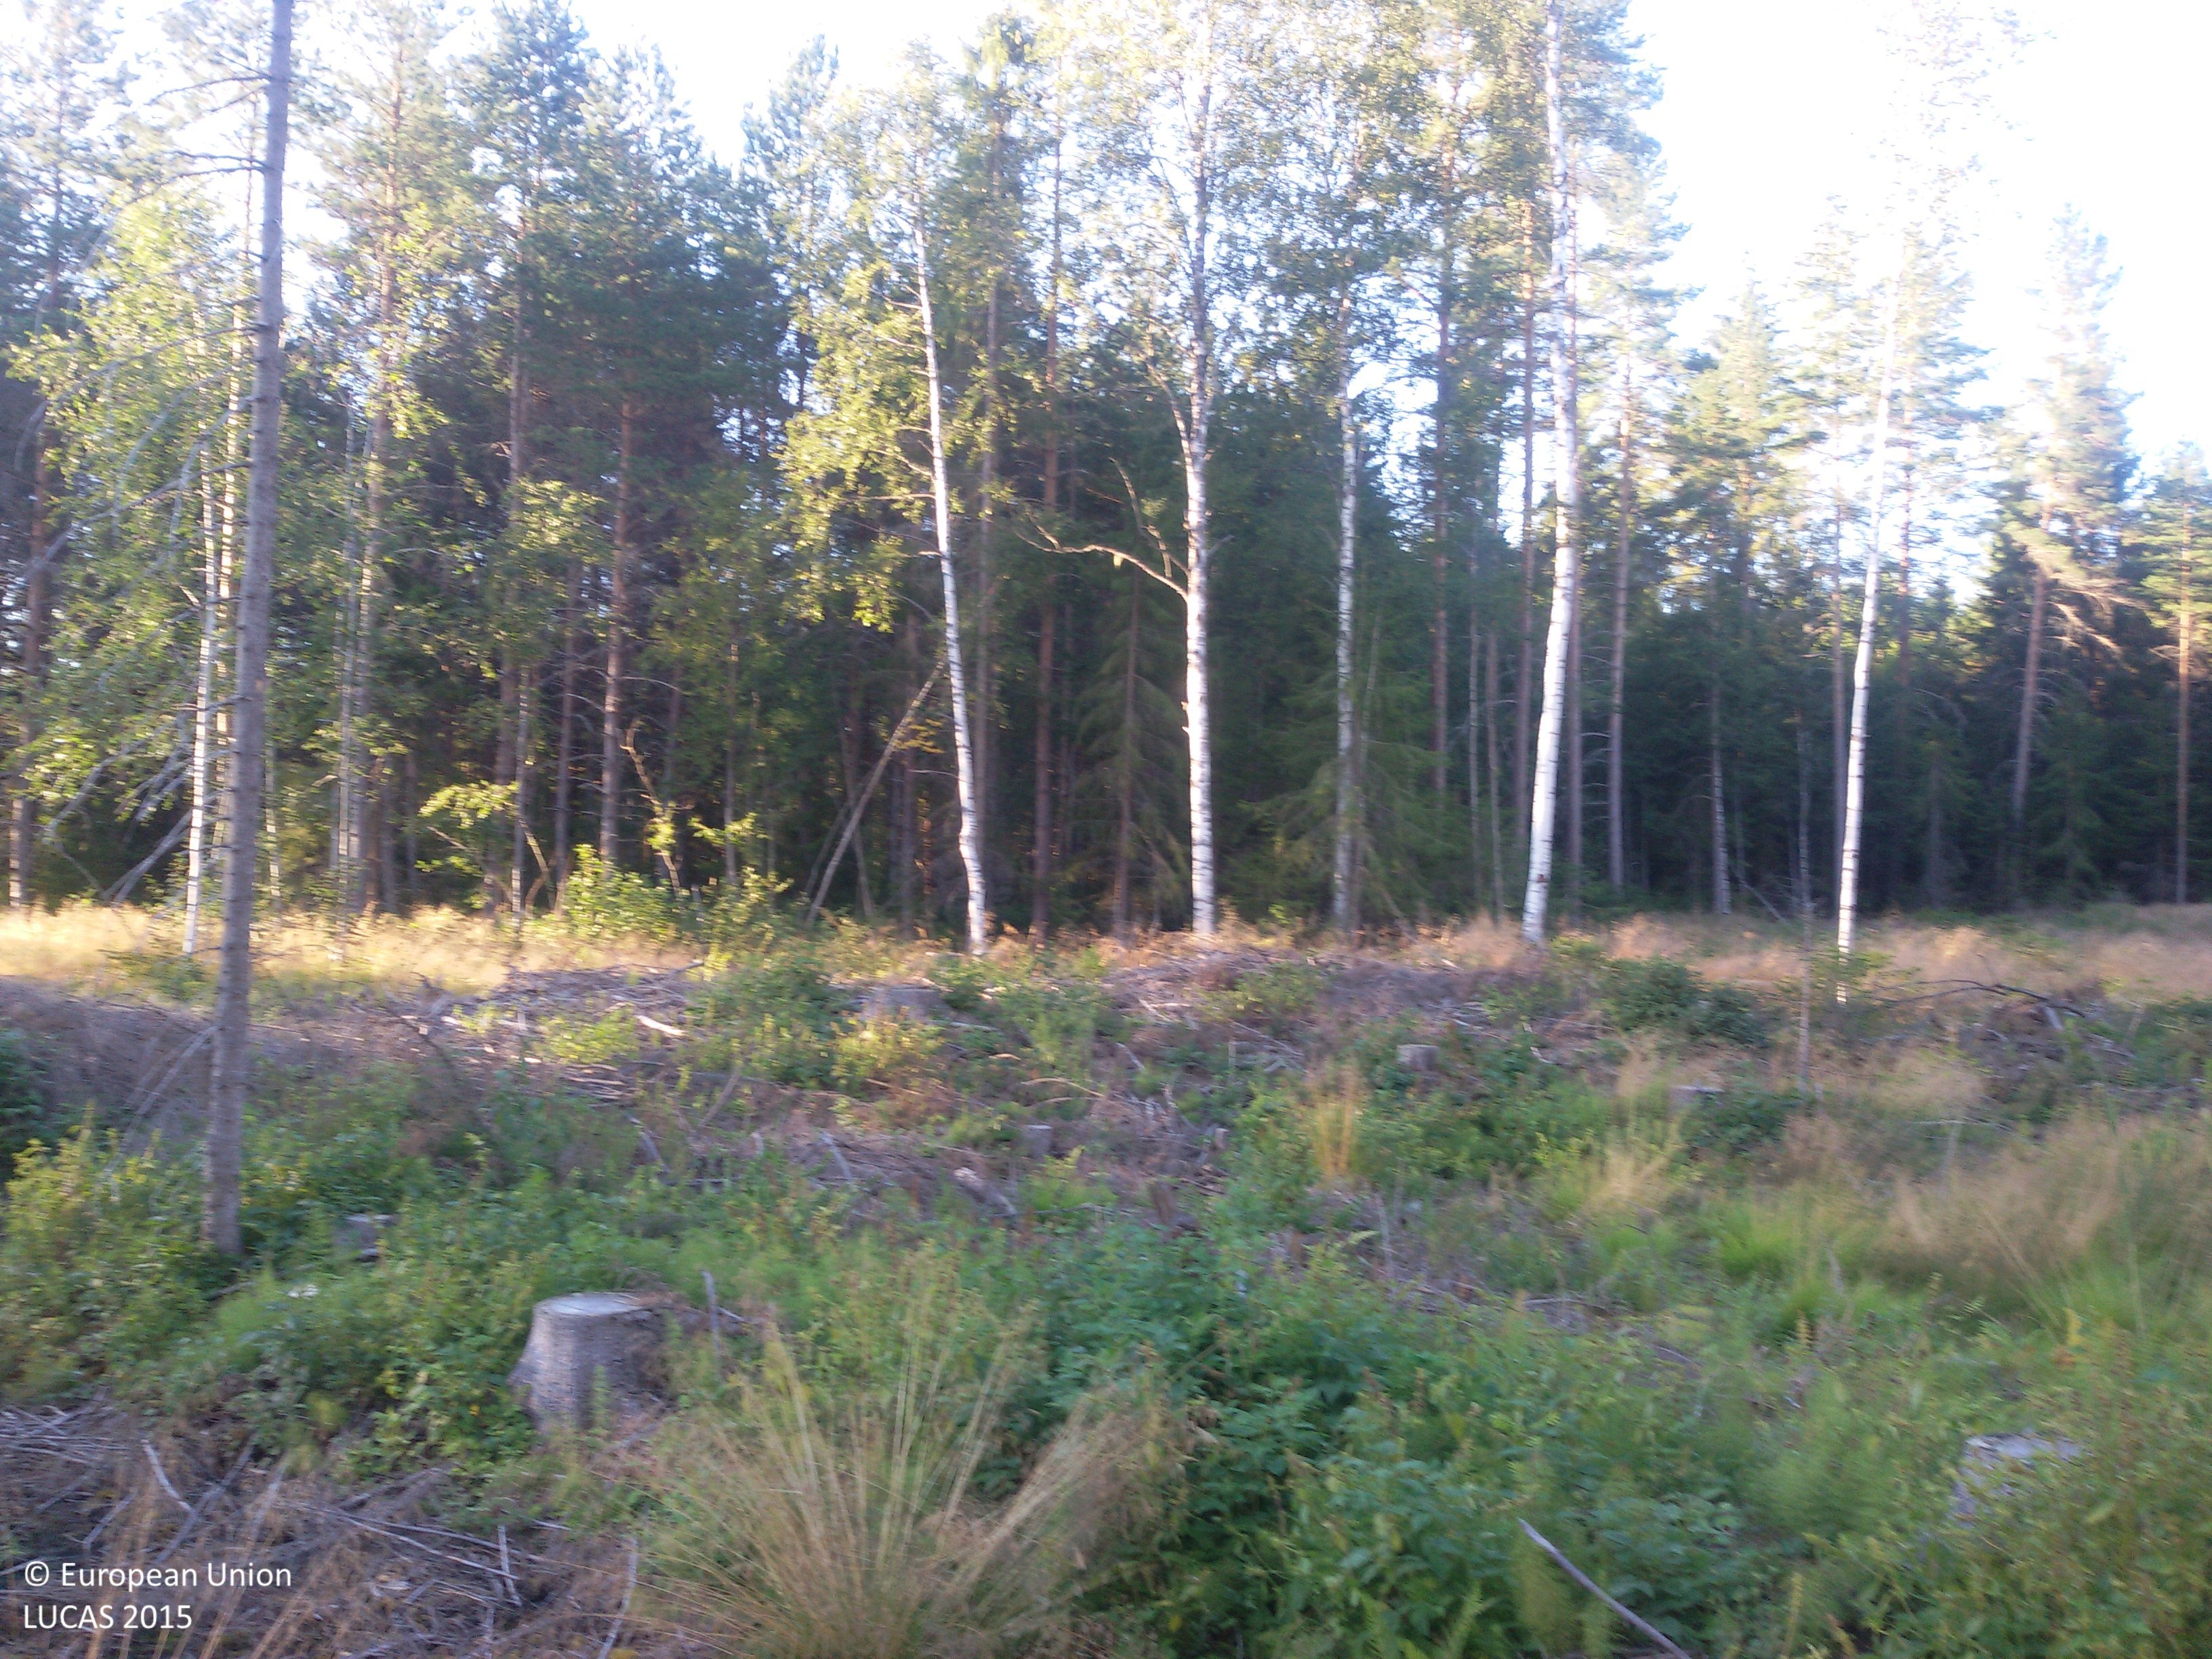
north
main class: Woodland
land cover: Pine dominated mixed woodland
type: boreal forest
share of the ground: 25 - 50 %
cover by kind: shrubs 50 %, lichens and mosses 20 %, coniferous forest trees 15 %, broadleaved forest trees 15 %
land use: Forestry
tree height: > 5 m
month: August
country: SE
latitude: 60.7102
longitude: 15.8324
